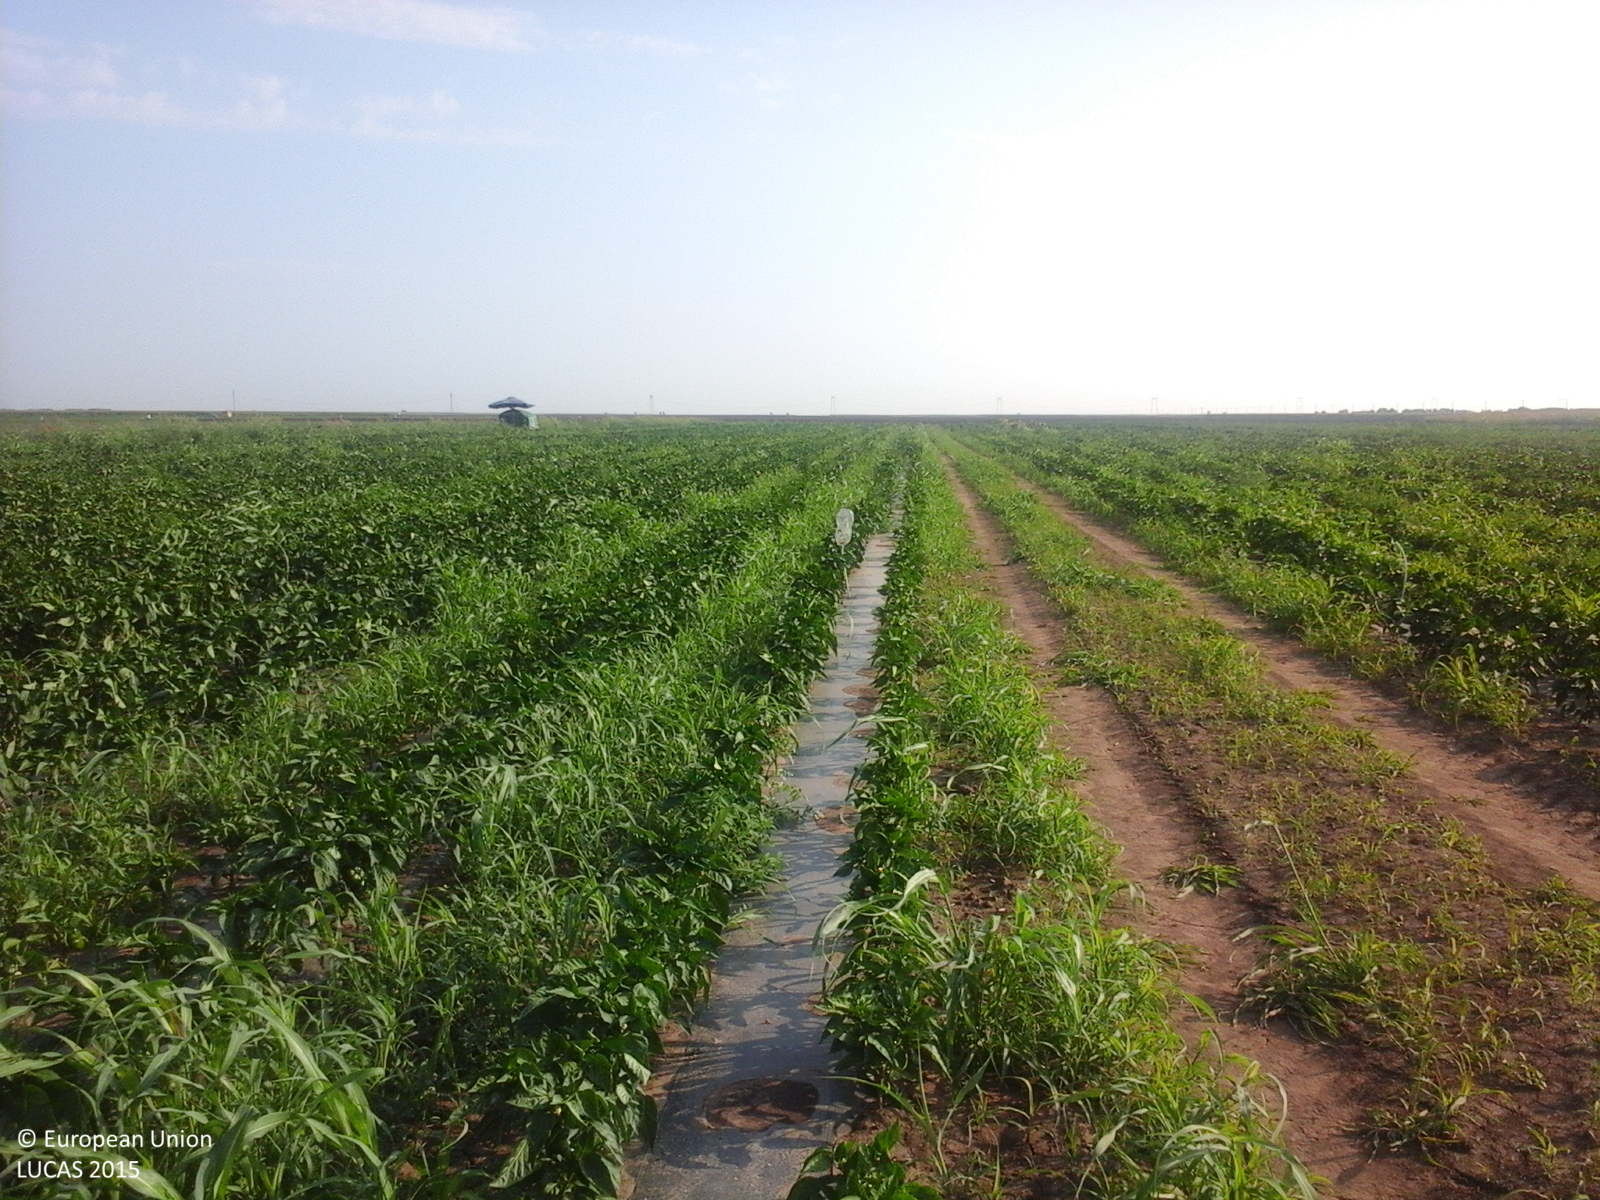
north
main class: Cropland
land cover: Other fresh vegetables
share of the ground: > 75 %
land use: Agriculture (excluding fallow land and kitchen gardens)
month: July
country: RO
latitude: 44.6114
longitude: 27.2102
